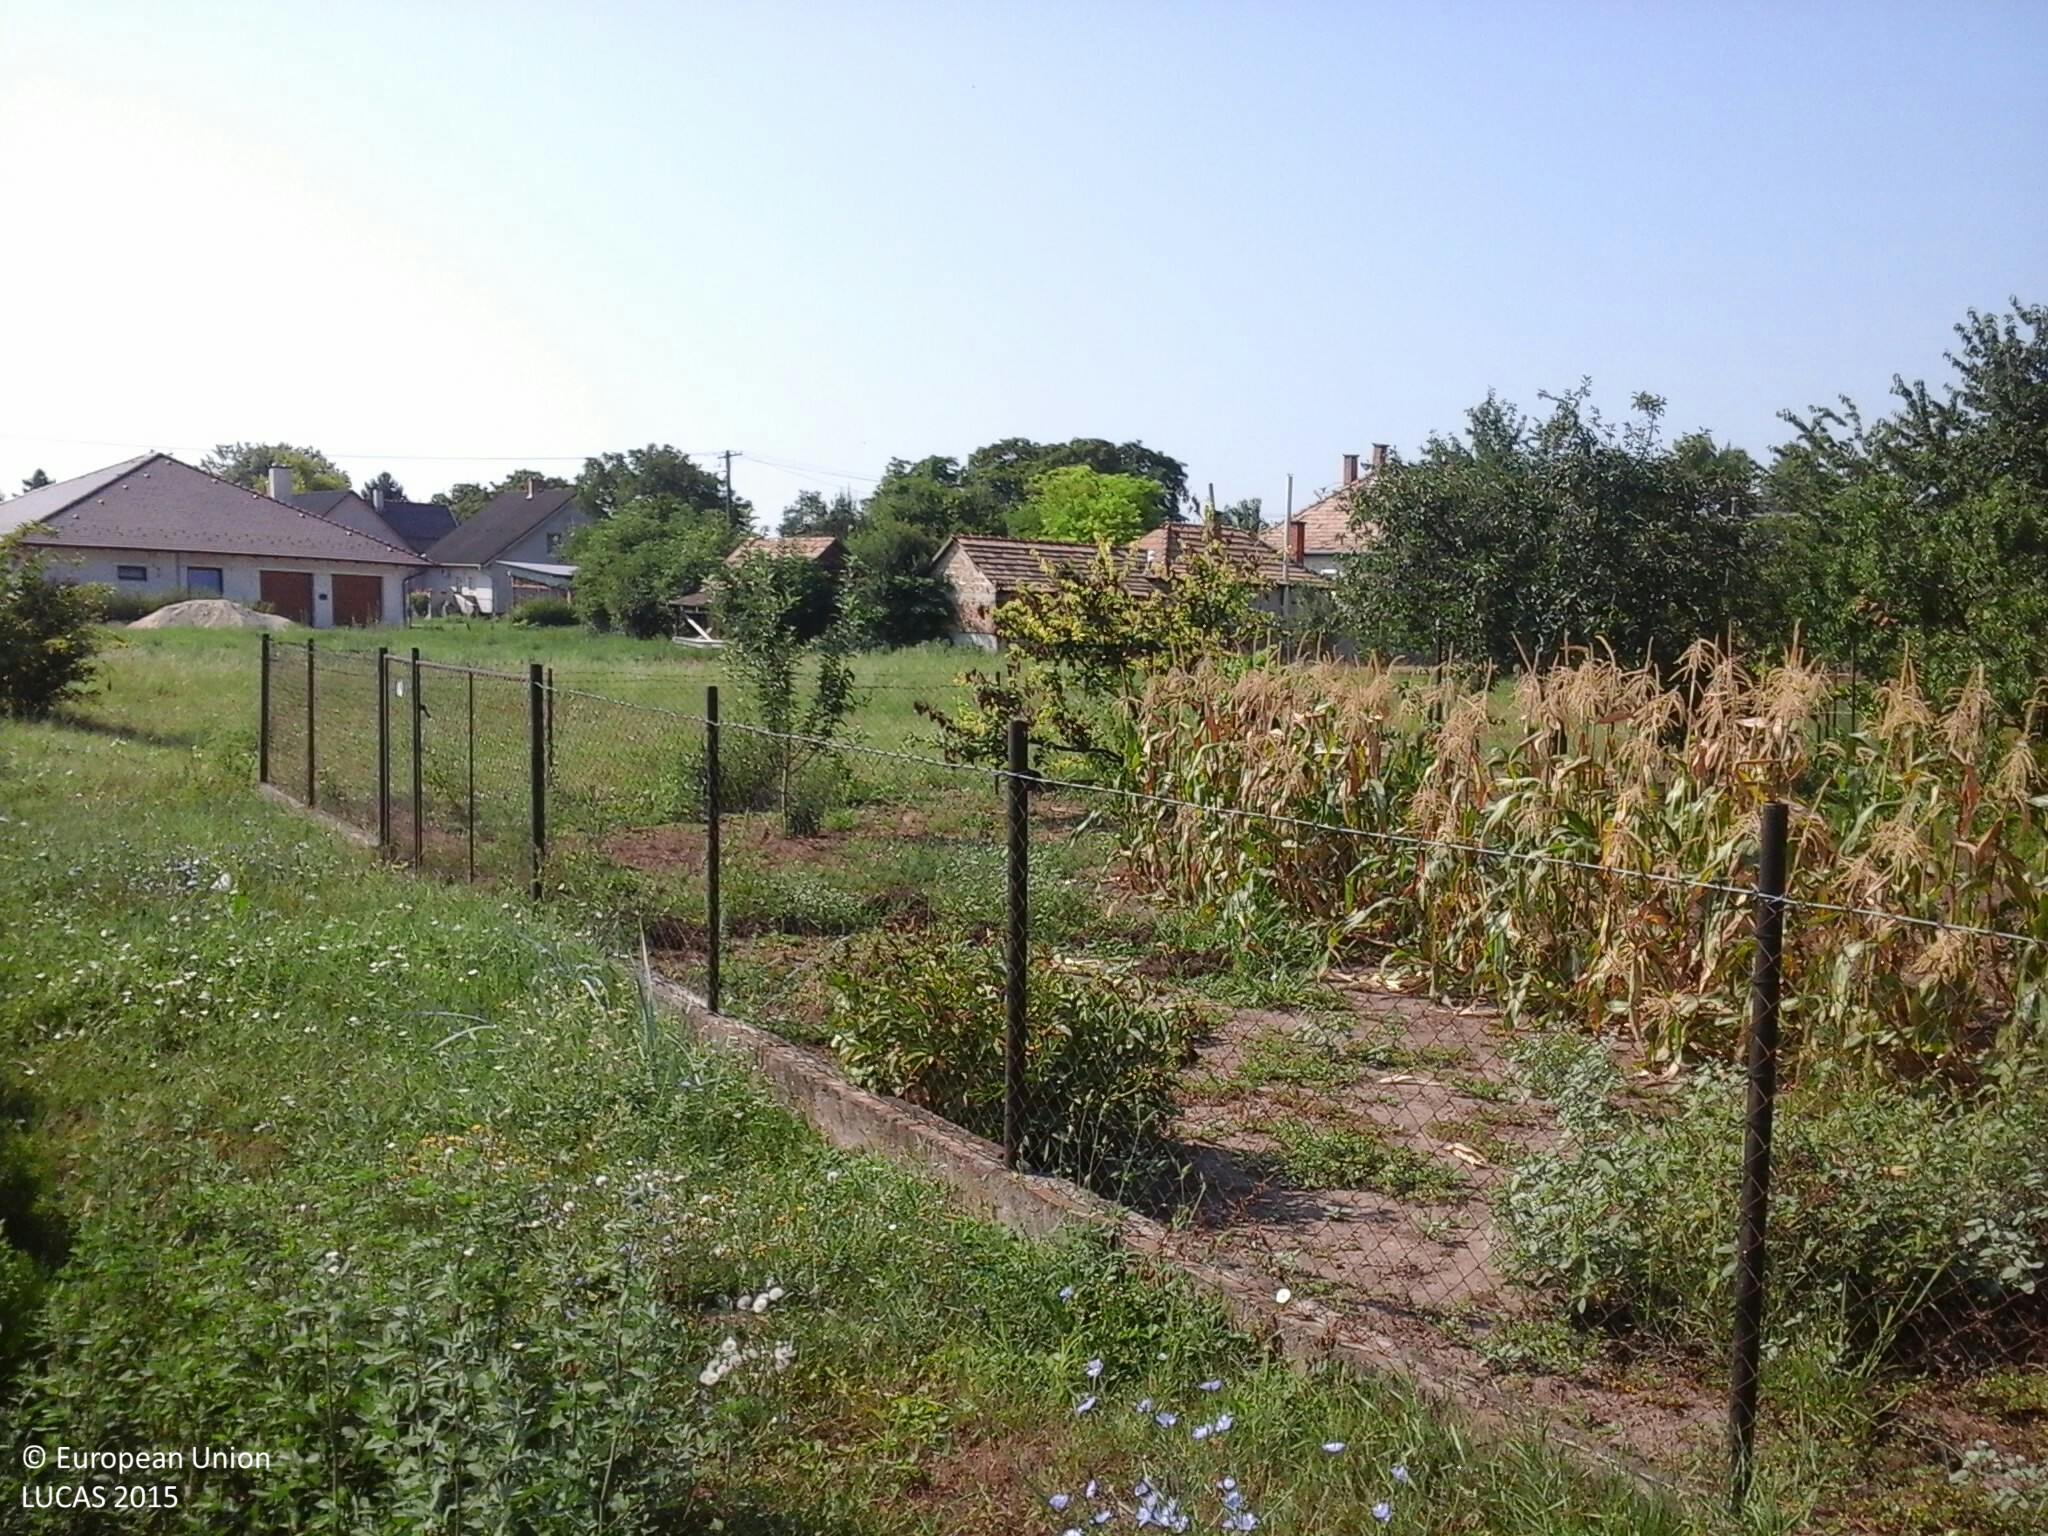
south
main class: Grassland
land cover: Grassland without tree/shrub cover
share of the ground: > 75 %
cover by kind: herbaceous plants 100 %
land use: Residential
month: August
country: HU
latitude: 46.9572
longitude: 18.2232
